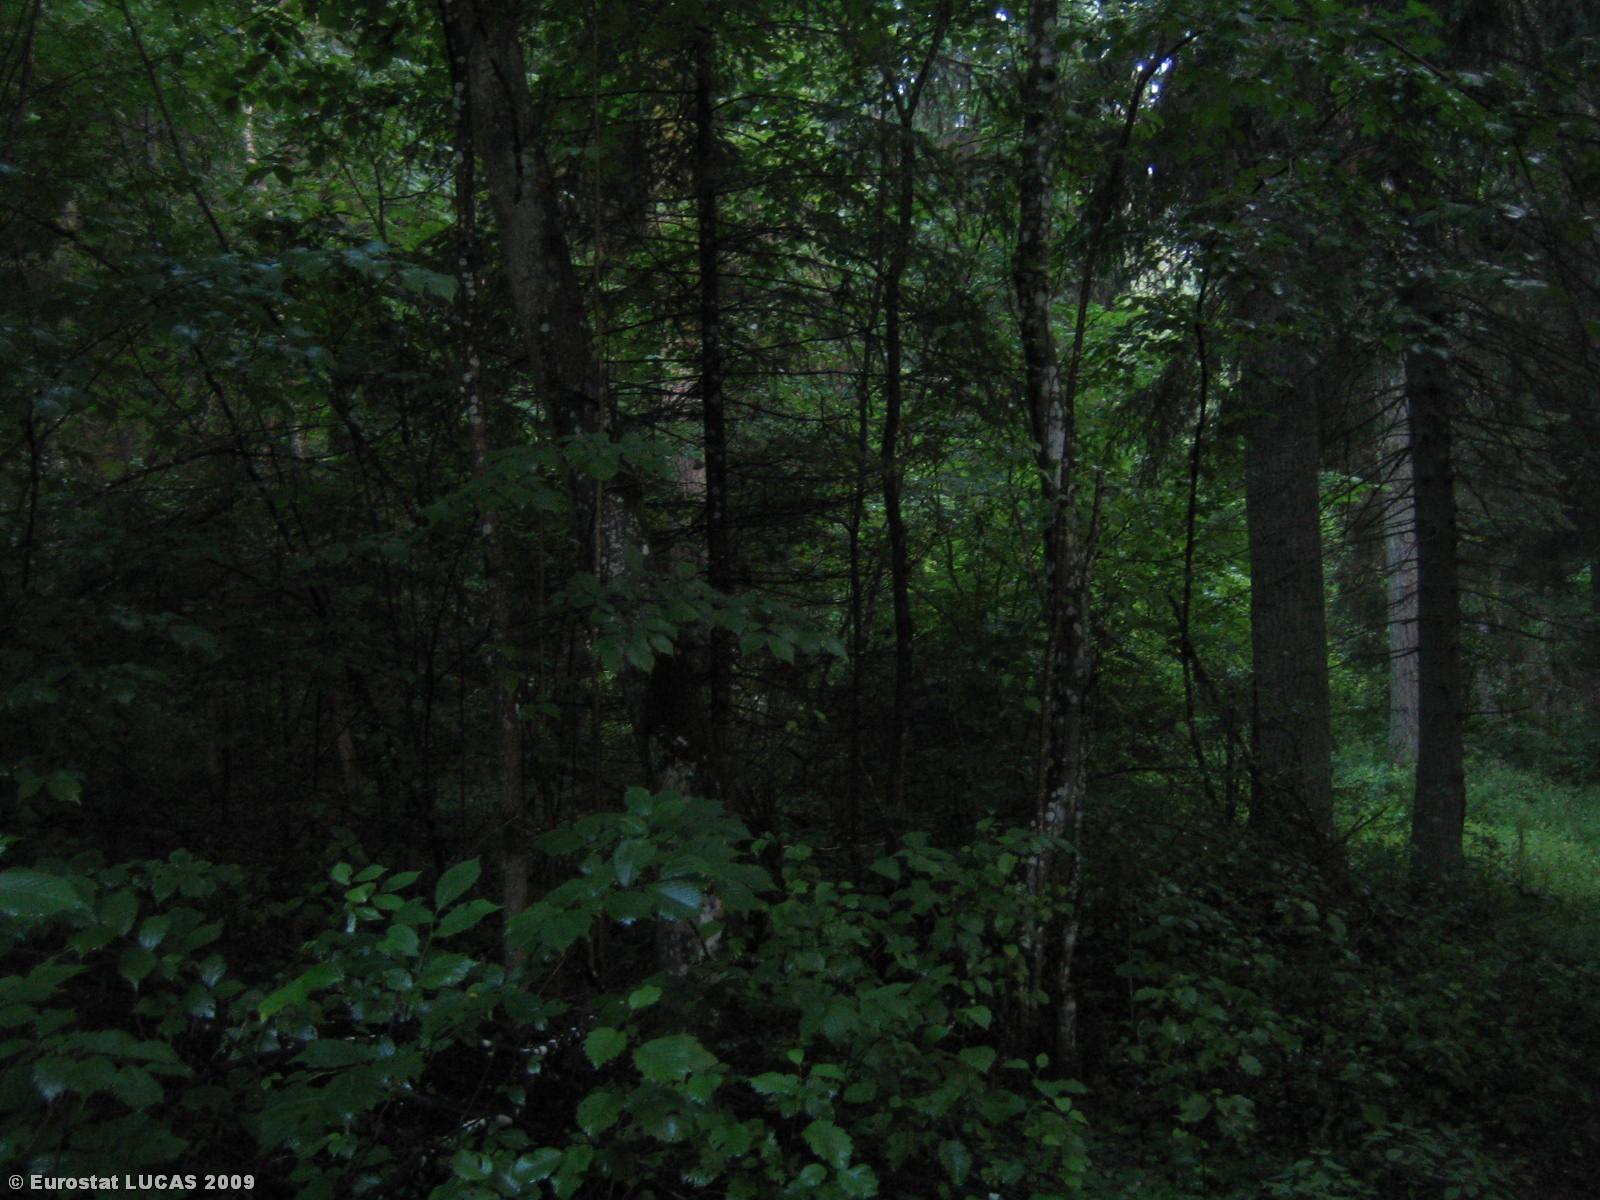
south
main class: Woodland
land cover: Mixed woodland
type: hemiboreal forest and nemoral coniferous forest and mixed broadleaved-coniferous forest
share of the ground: > 75 %
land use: Forestry
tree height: > 5 m
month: August
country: LT
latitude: 54.6790
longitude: 24.6697
